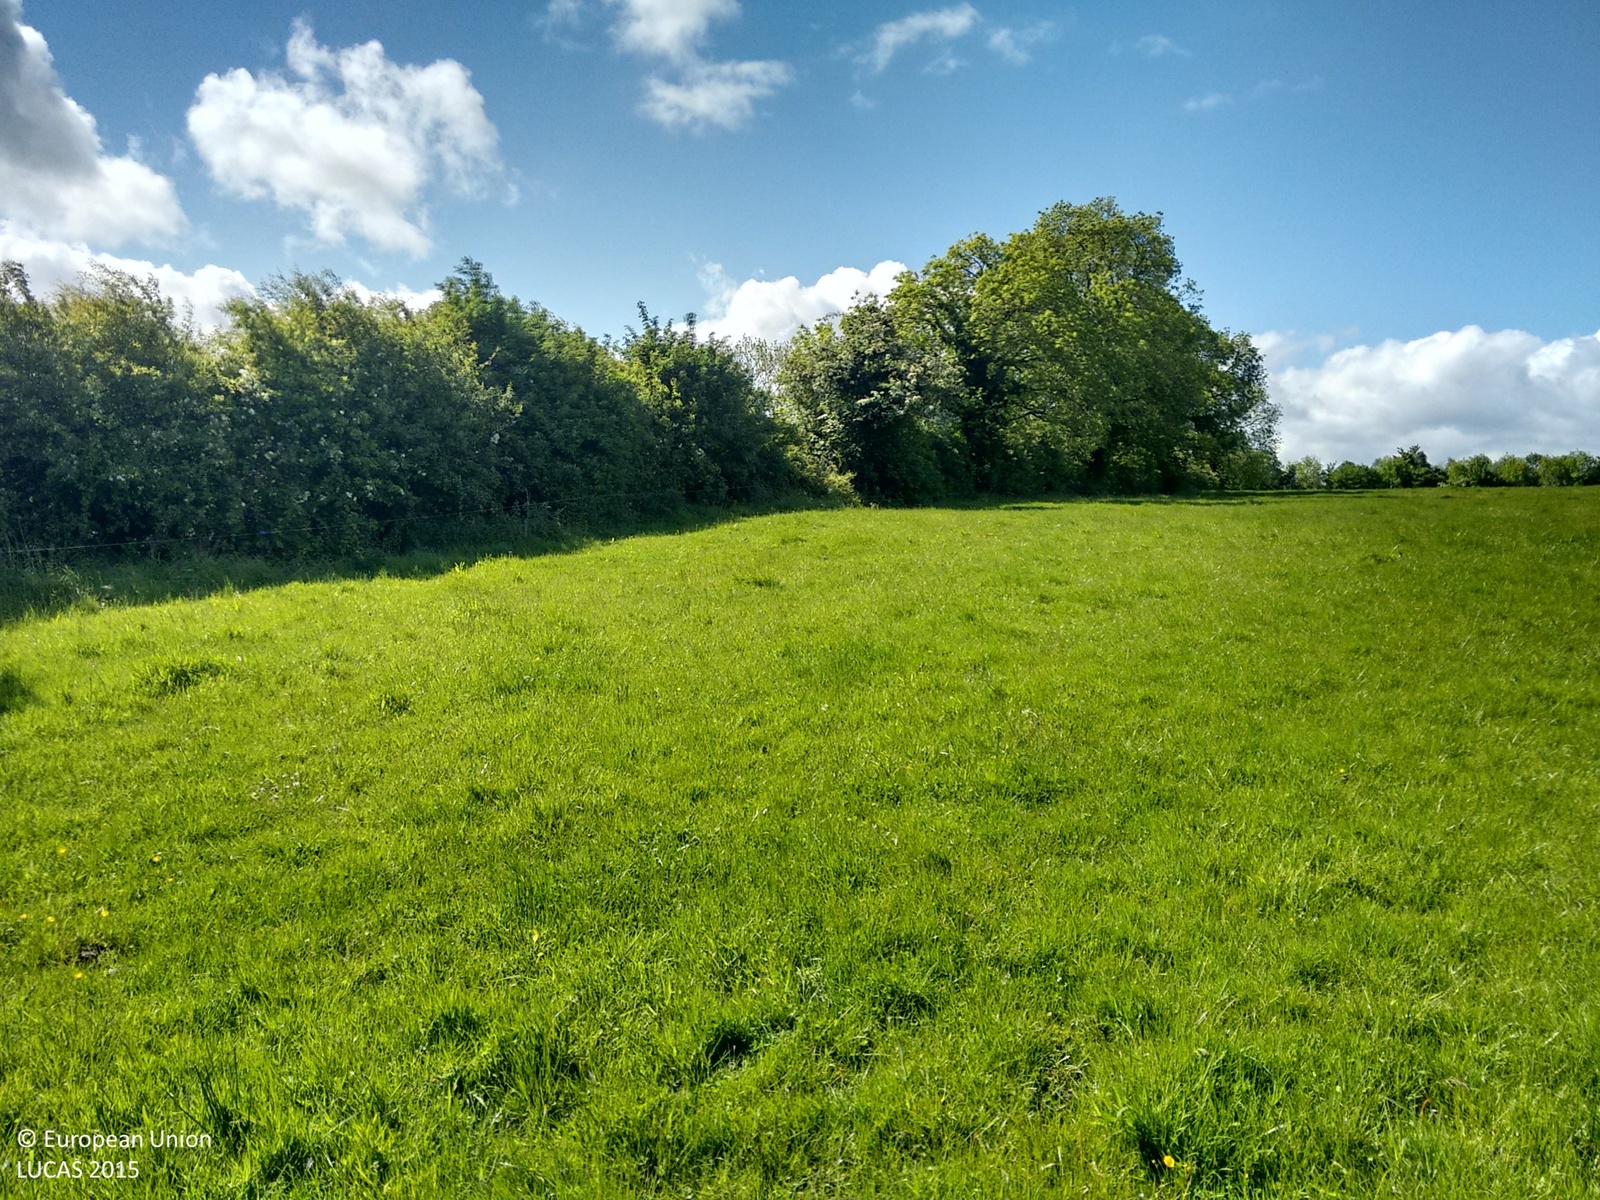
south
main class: Grassland
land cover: Grassland without tree/shrub cover
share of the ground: > 75 %
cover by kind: herbaceous plants 100 %
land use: Agriculture (excluding fallow land and kitchen gardens)
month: June
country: IE
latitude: 53.3878
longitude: -6.9660
